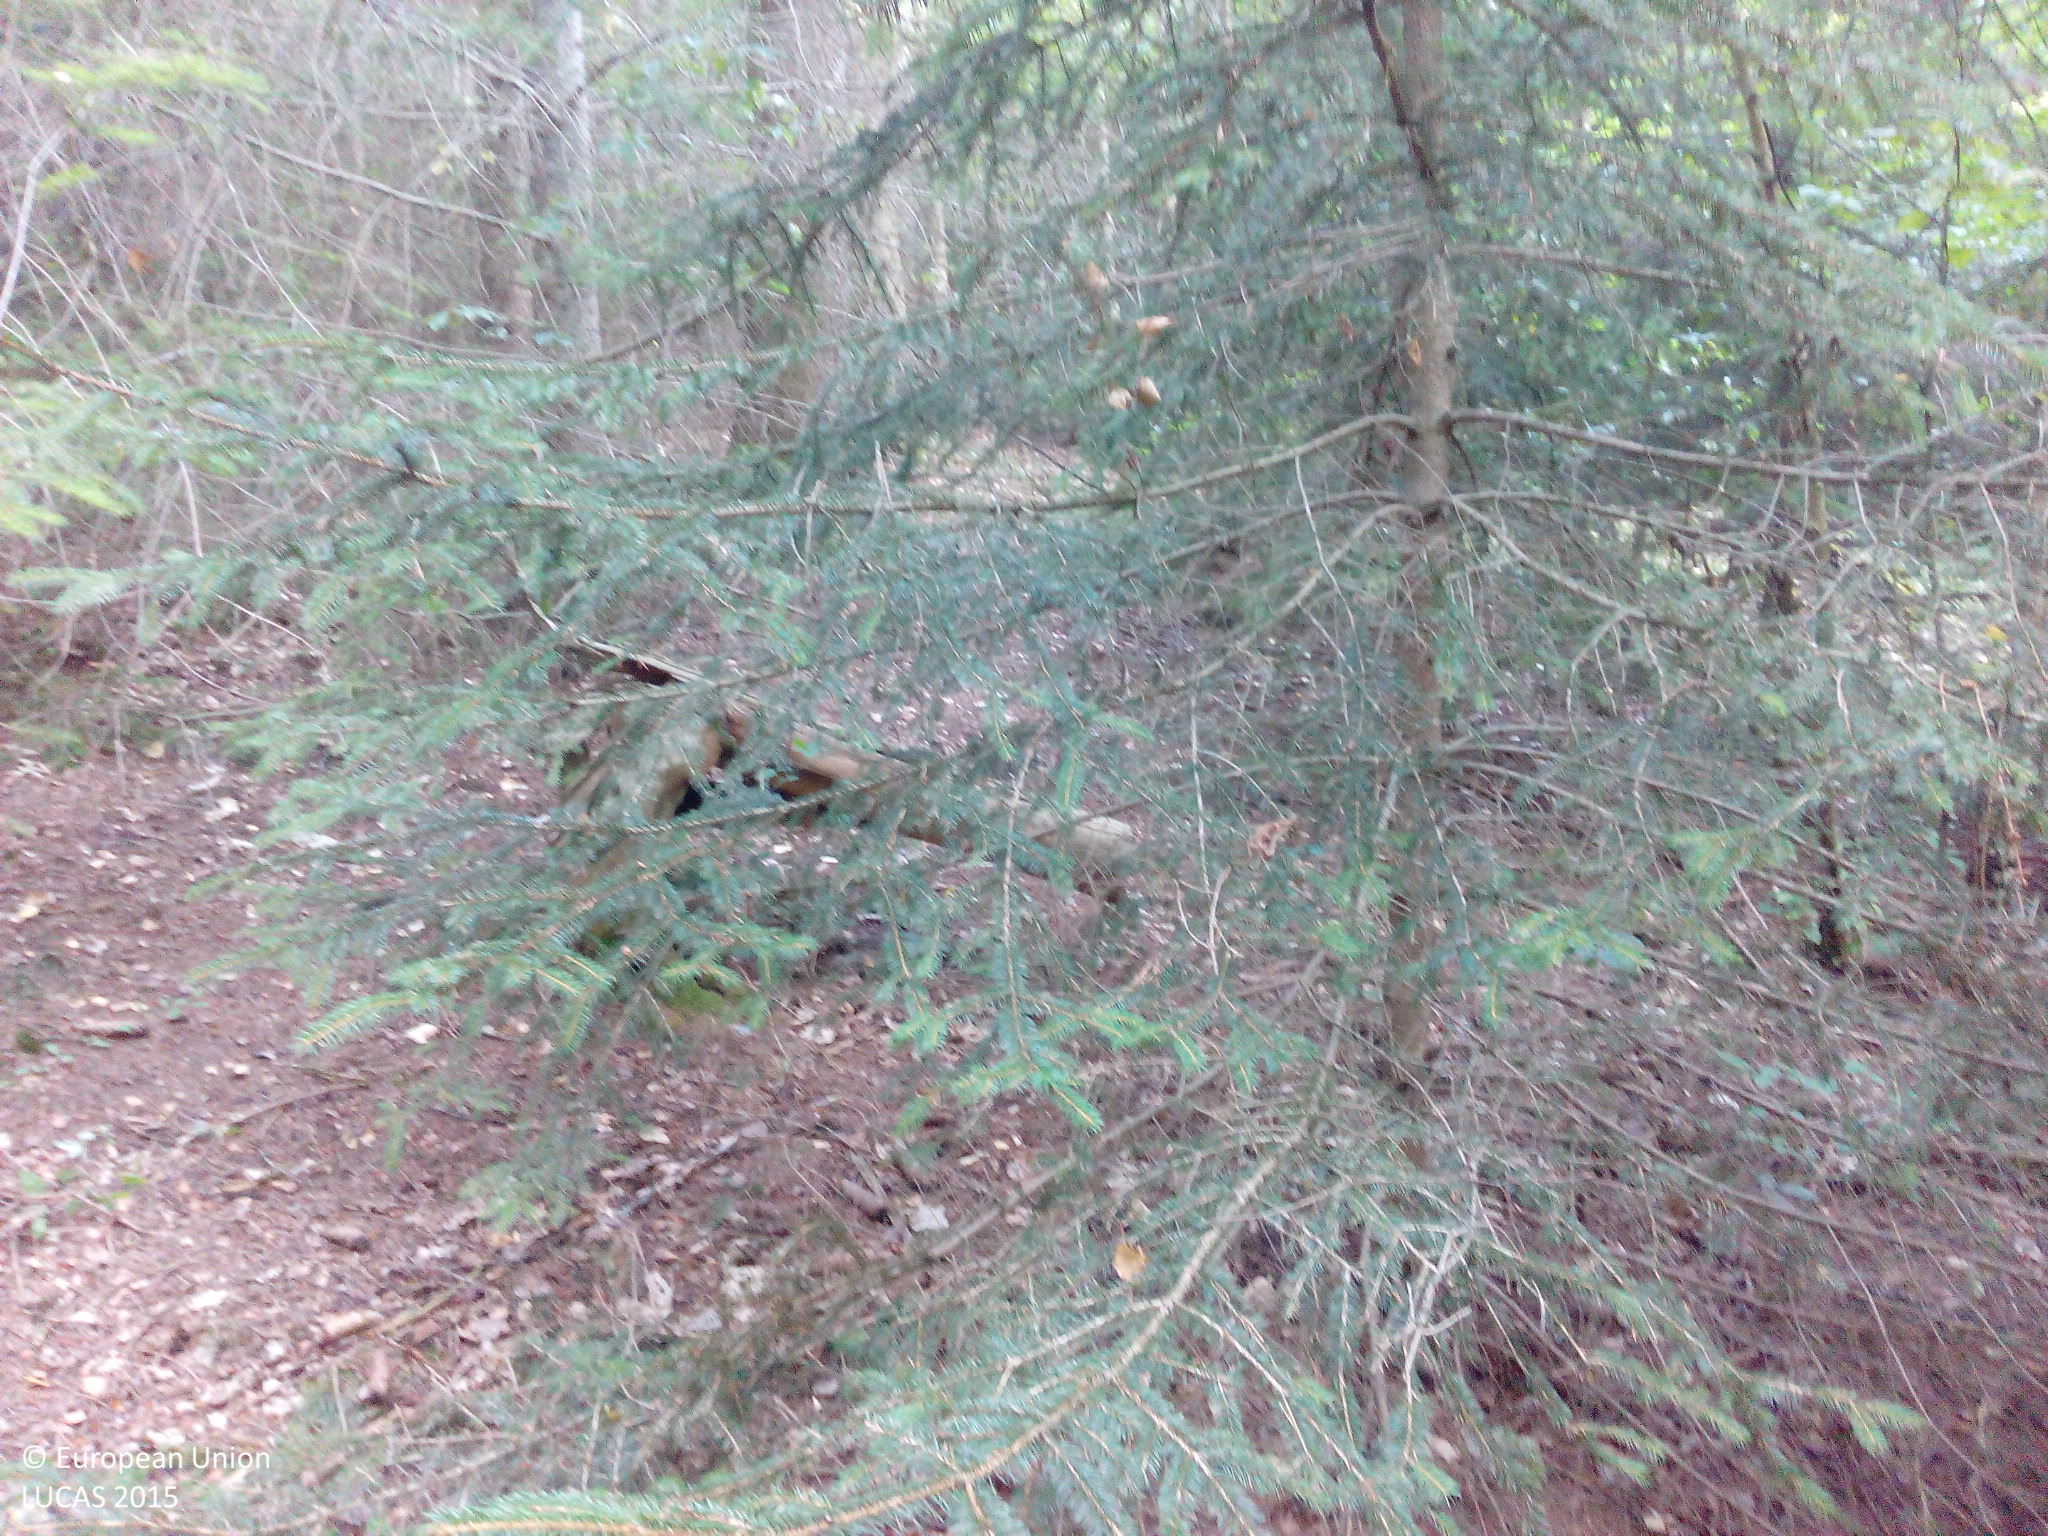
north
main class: Woodland
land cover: Spruce dominated mixed woodland
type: mesophytic deciduous forest
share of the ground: > 75 %
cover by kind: coniferous forest trees 50 %, broadleaved forest trees 25 %, herbaceous plants 10 %, lichens and mosses 10 %, unconsolidated bare surface 5 %
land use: Forestry
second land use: Amenities, museums, leisure
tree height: > 5 m
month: August
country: DE
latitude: 50.2119
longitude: 7.5480
